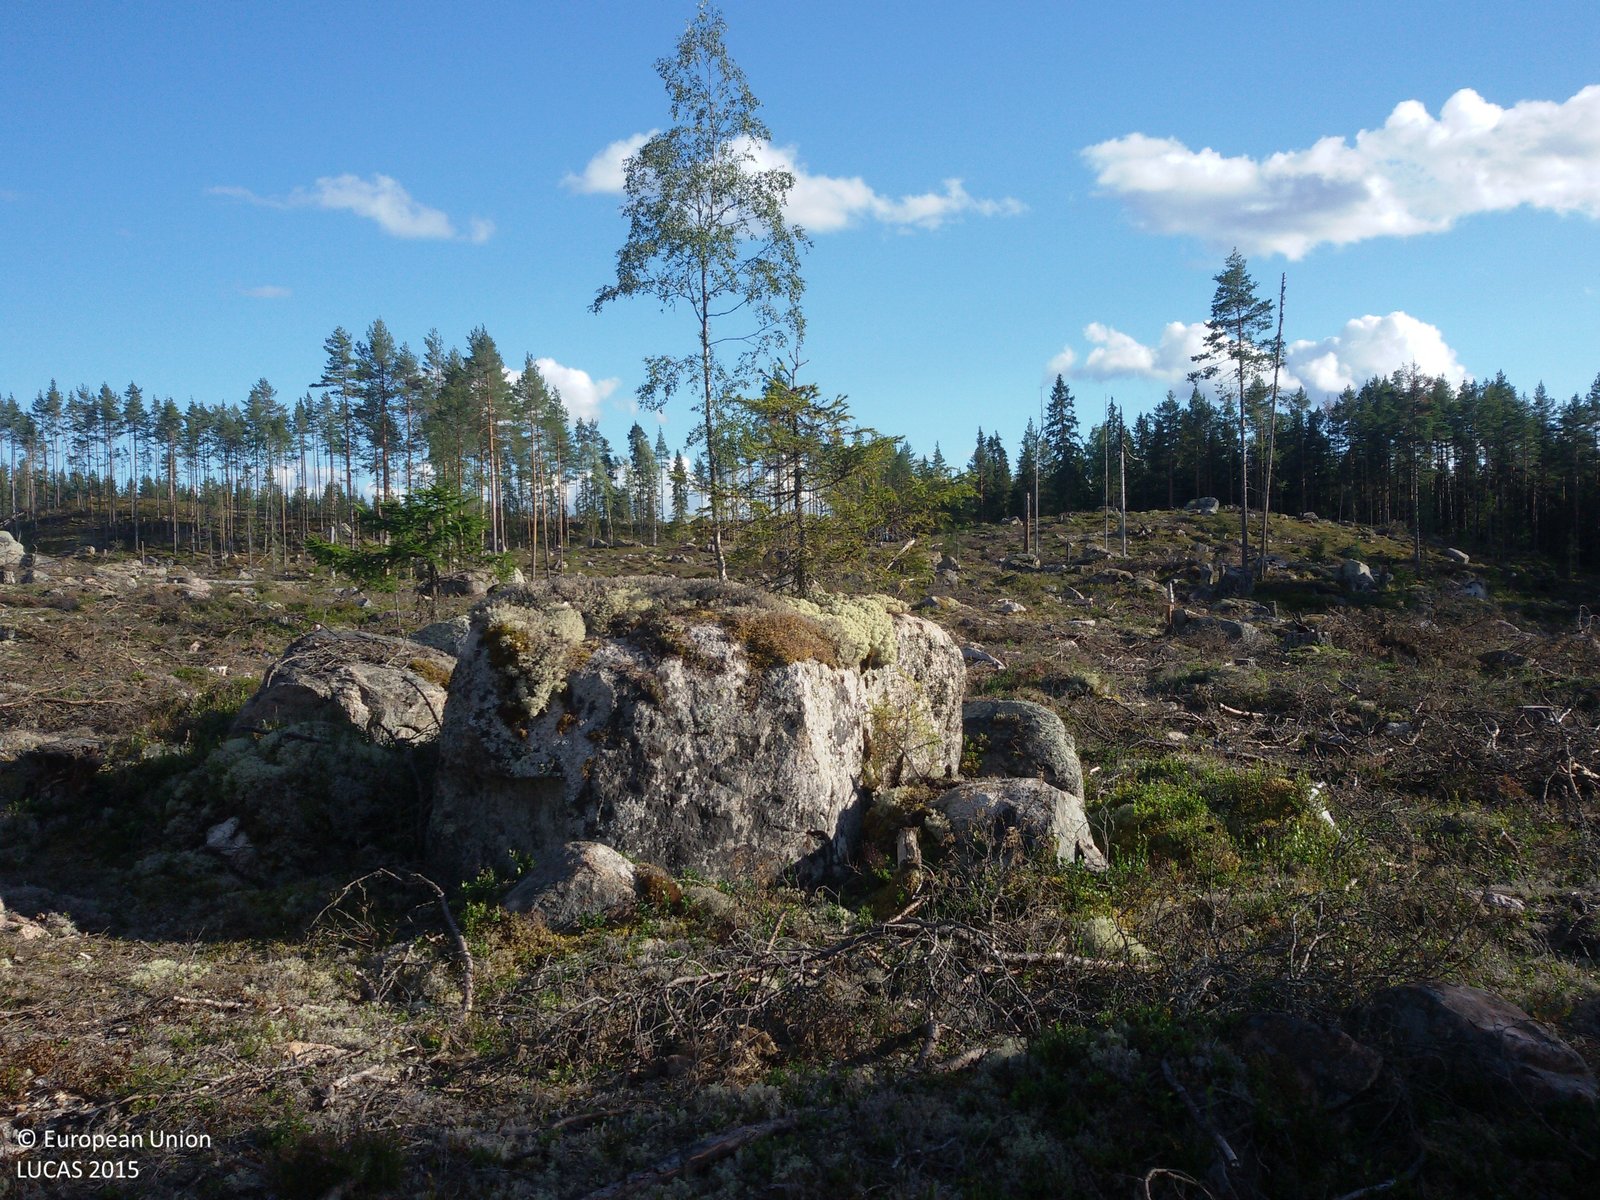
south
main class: Shrubland
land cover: Shrubland with sparse tree cover
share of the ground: 50 - 75 %
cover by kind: shrubs 70 %, lichens and mosses 10 %, coniferous forest trees 5 %
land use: Forestry
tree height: < 5 m
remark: Clear cut
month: August
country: SE
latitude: 60.9104
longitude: 15.7945
